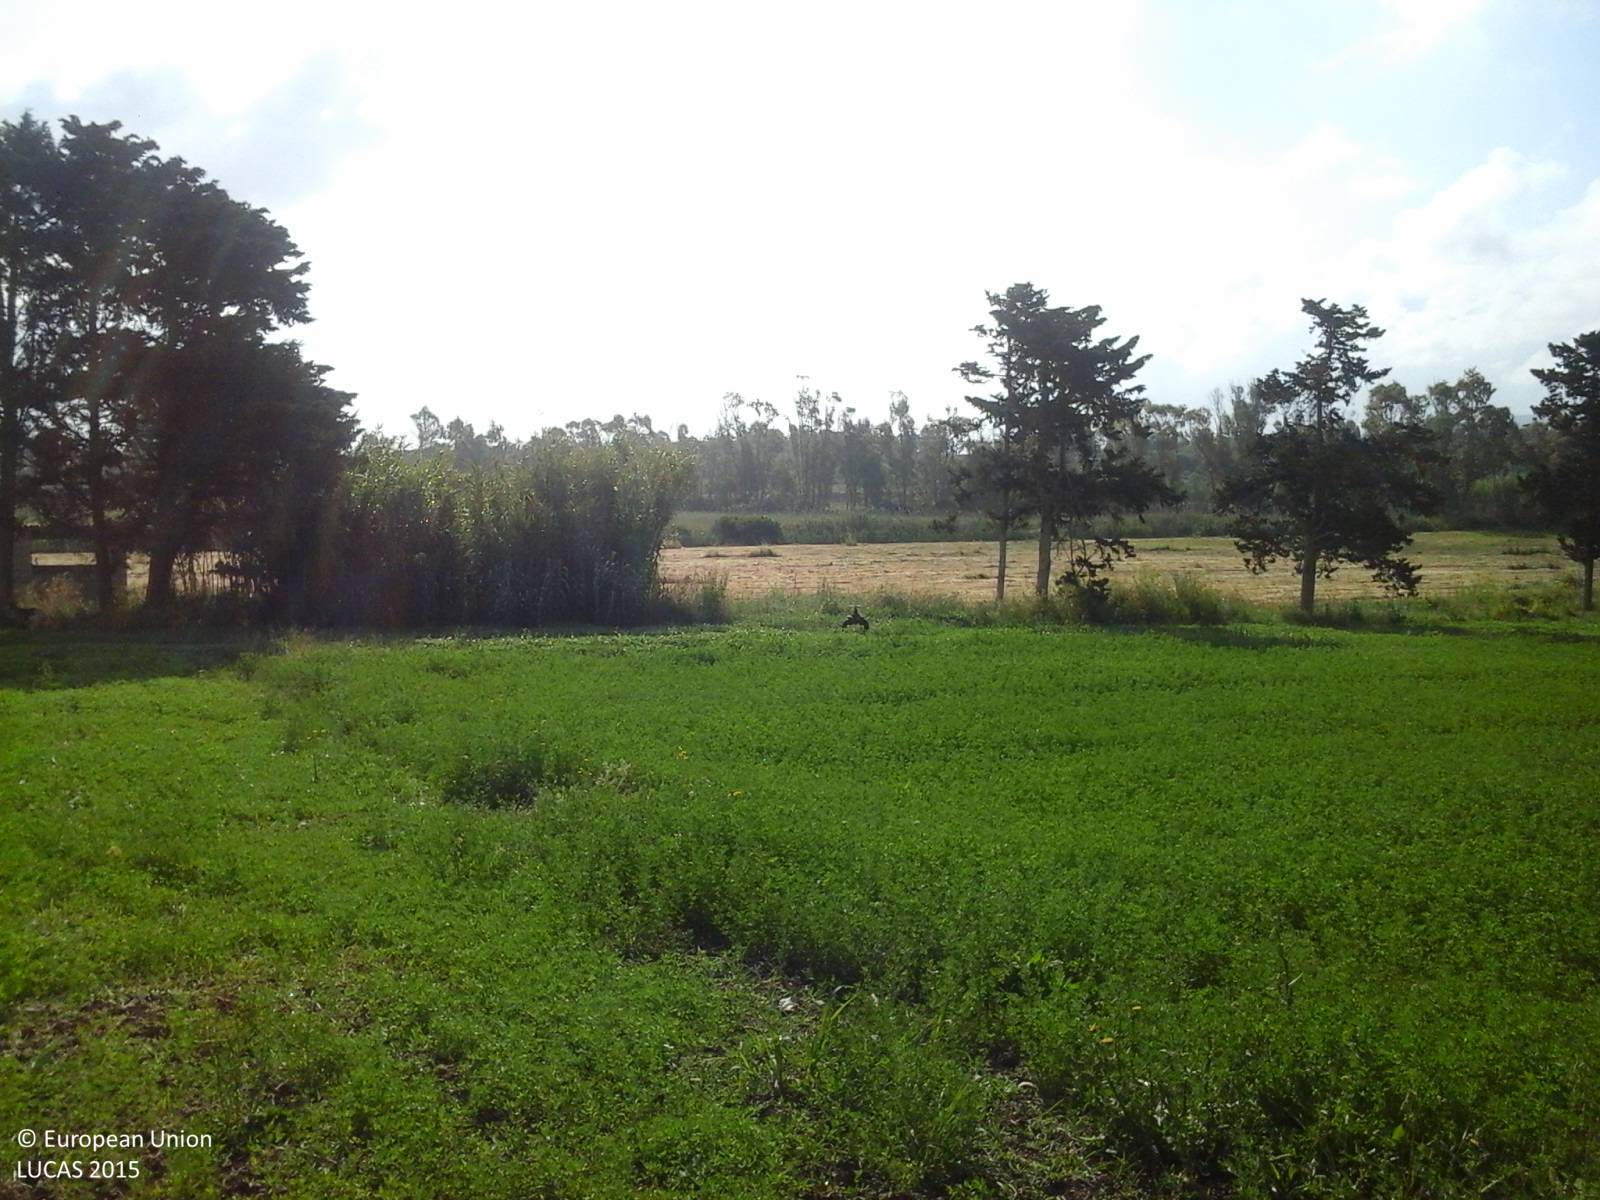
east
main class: Cropland
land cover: Lucerne
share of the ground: 50 - 75 %
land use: Agriculture (excluding fallow land and kitchen gardens)
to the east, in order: Lucerne; Single bushes/trees; Fences; Grassland without tree/shrub cover; Single bushes/trees; Fences; Grassland without tree/shrub cover
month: May
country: IT
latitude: 40.6881
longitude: 8.3631
